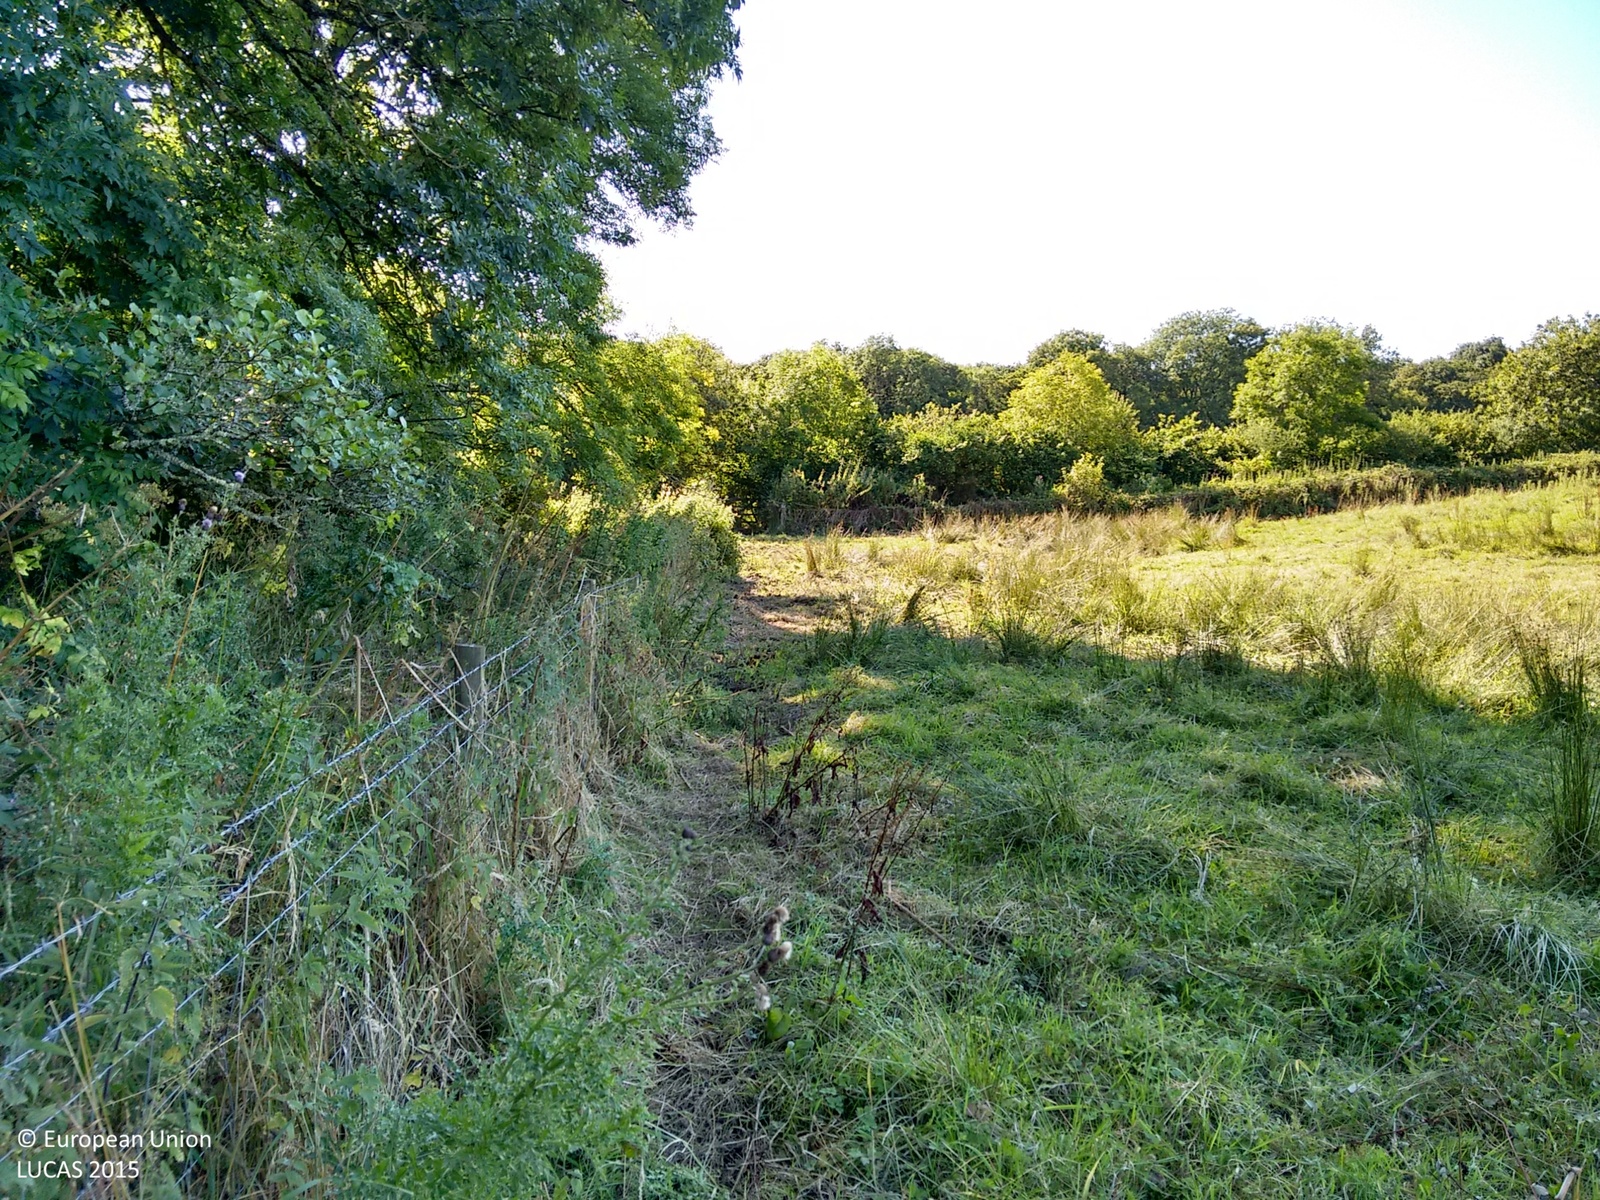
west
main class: Woodland
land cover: Broadleaved woodland
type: mesophytic deciduous forest
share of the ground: > 75 %
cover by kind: broadleaved forest trees 70 %, shrubs 30 %
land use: Semi-natural and natural areas not in use
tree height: > 5 m
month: August
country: GB
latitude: 51.6990
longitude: -4.7981
